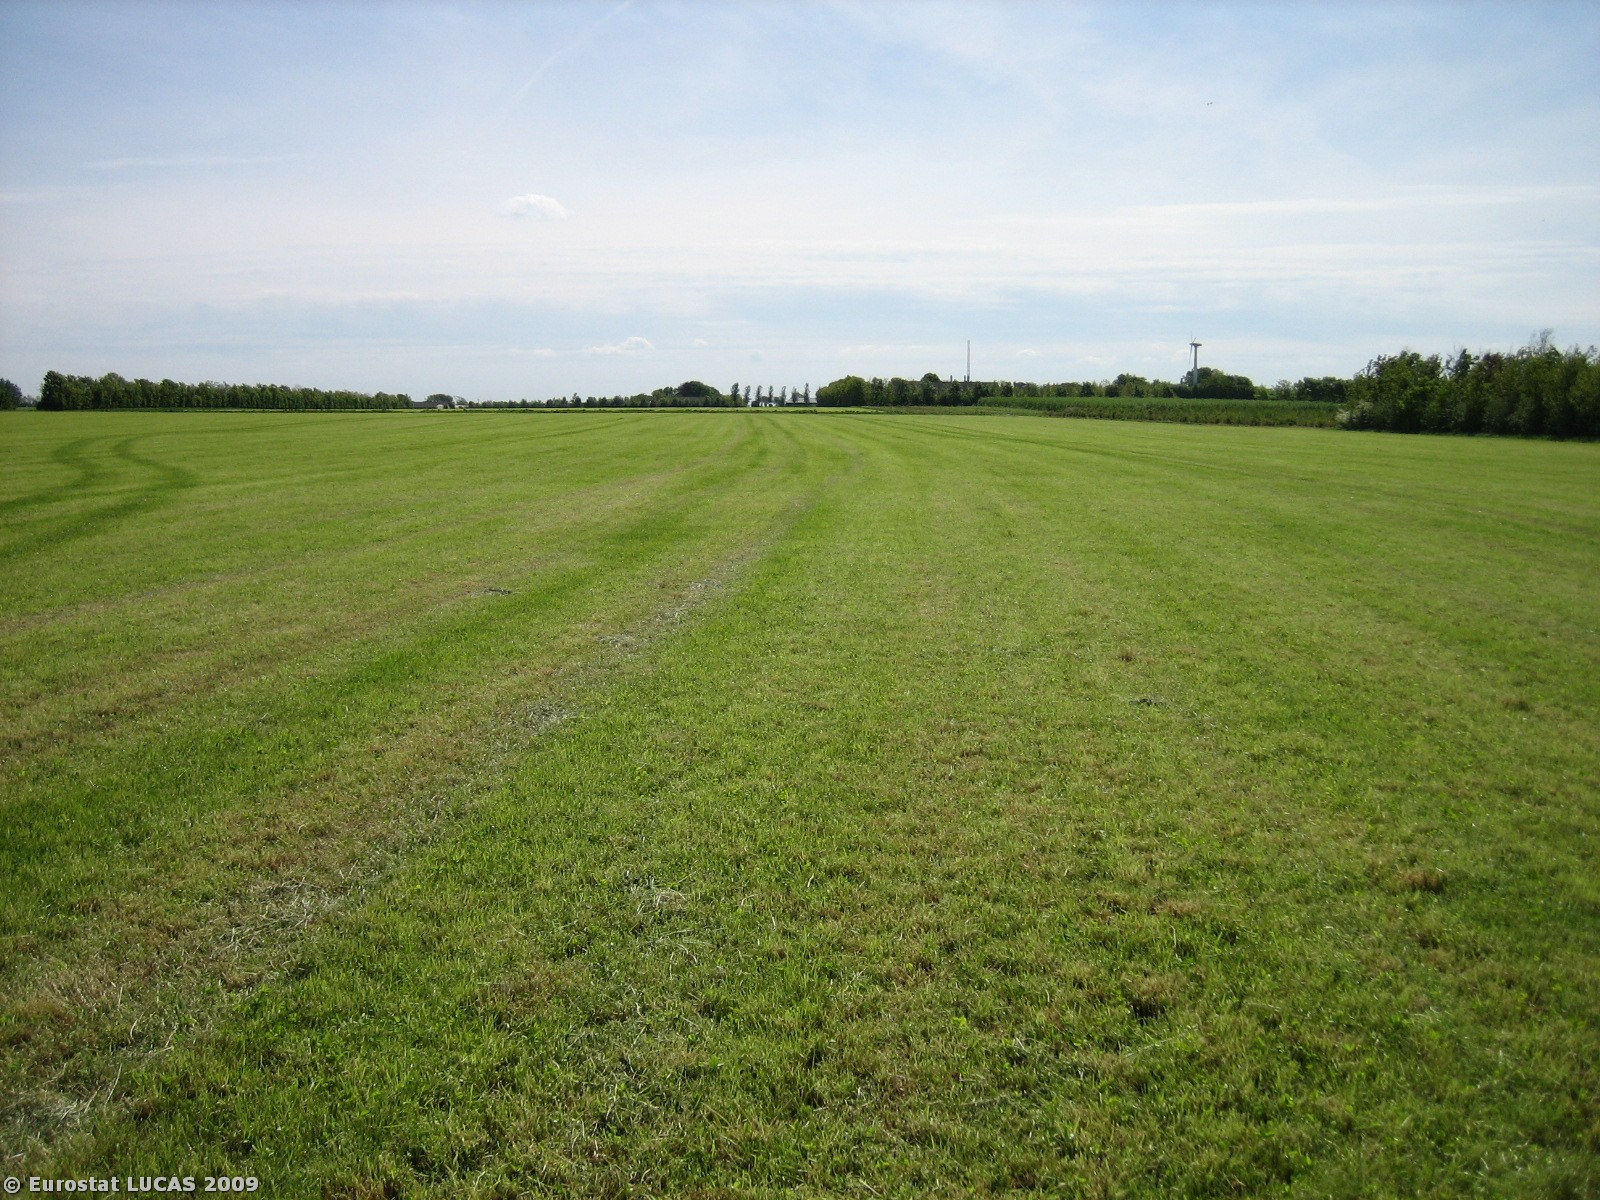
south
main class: Grassland
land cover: Grassland without tree/shrub cover
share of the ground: > 75 %
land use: Agriculture (excluding fallow land and kitchen gardens)
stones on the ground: < 10 %
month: May
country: DK
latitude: 56.0184
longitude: 8.6058
